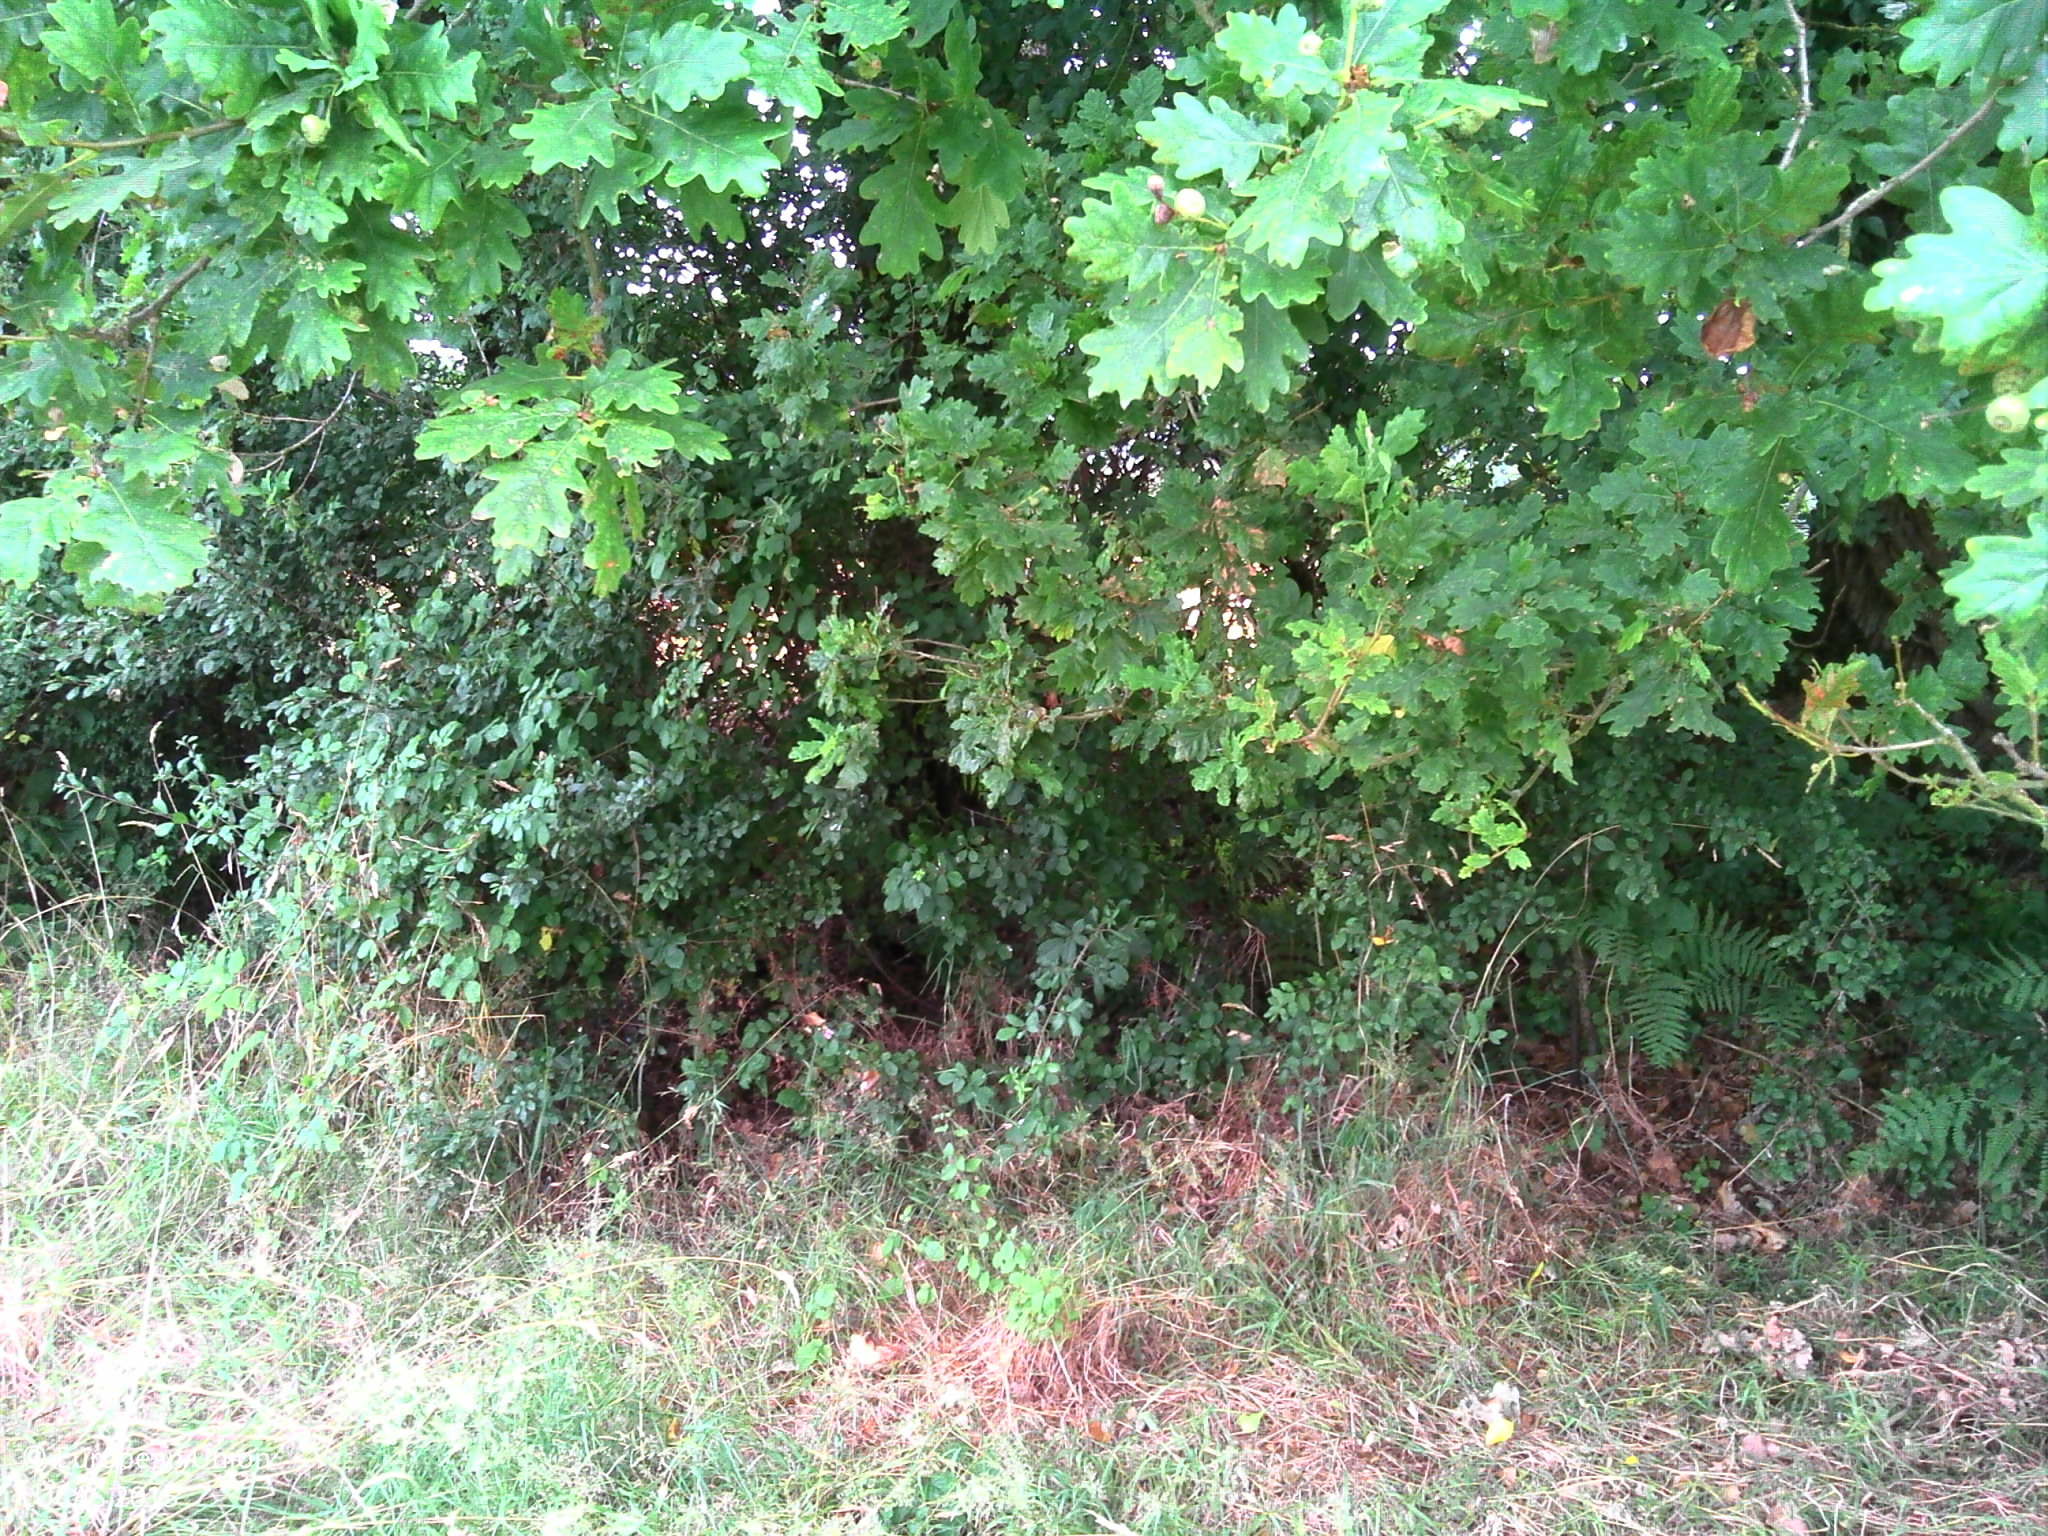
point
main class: Woodland
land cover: Broadleaved woodland
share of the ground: > 75 %
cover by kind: broadleaved forest trees 80 %, herbaceous plants 20 %
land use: Semi-natural and natural areas not in use
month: July
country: FR
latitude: 48.3963
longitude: -0.0650
